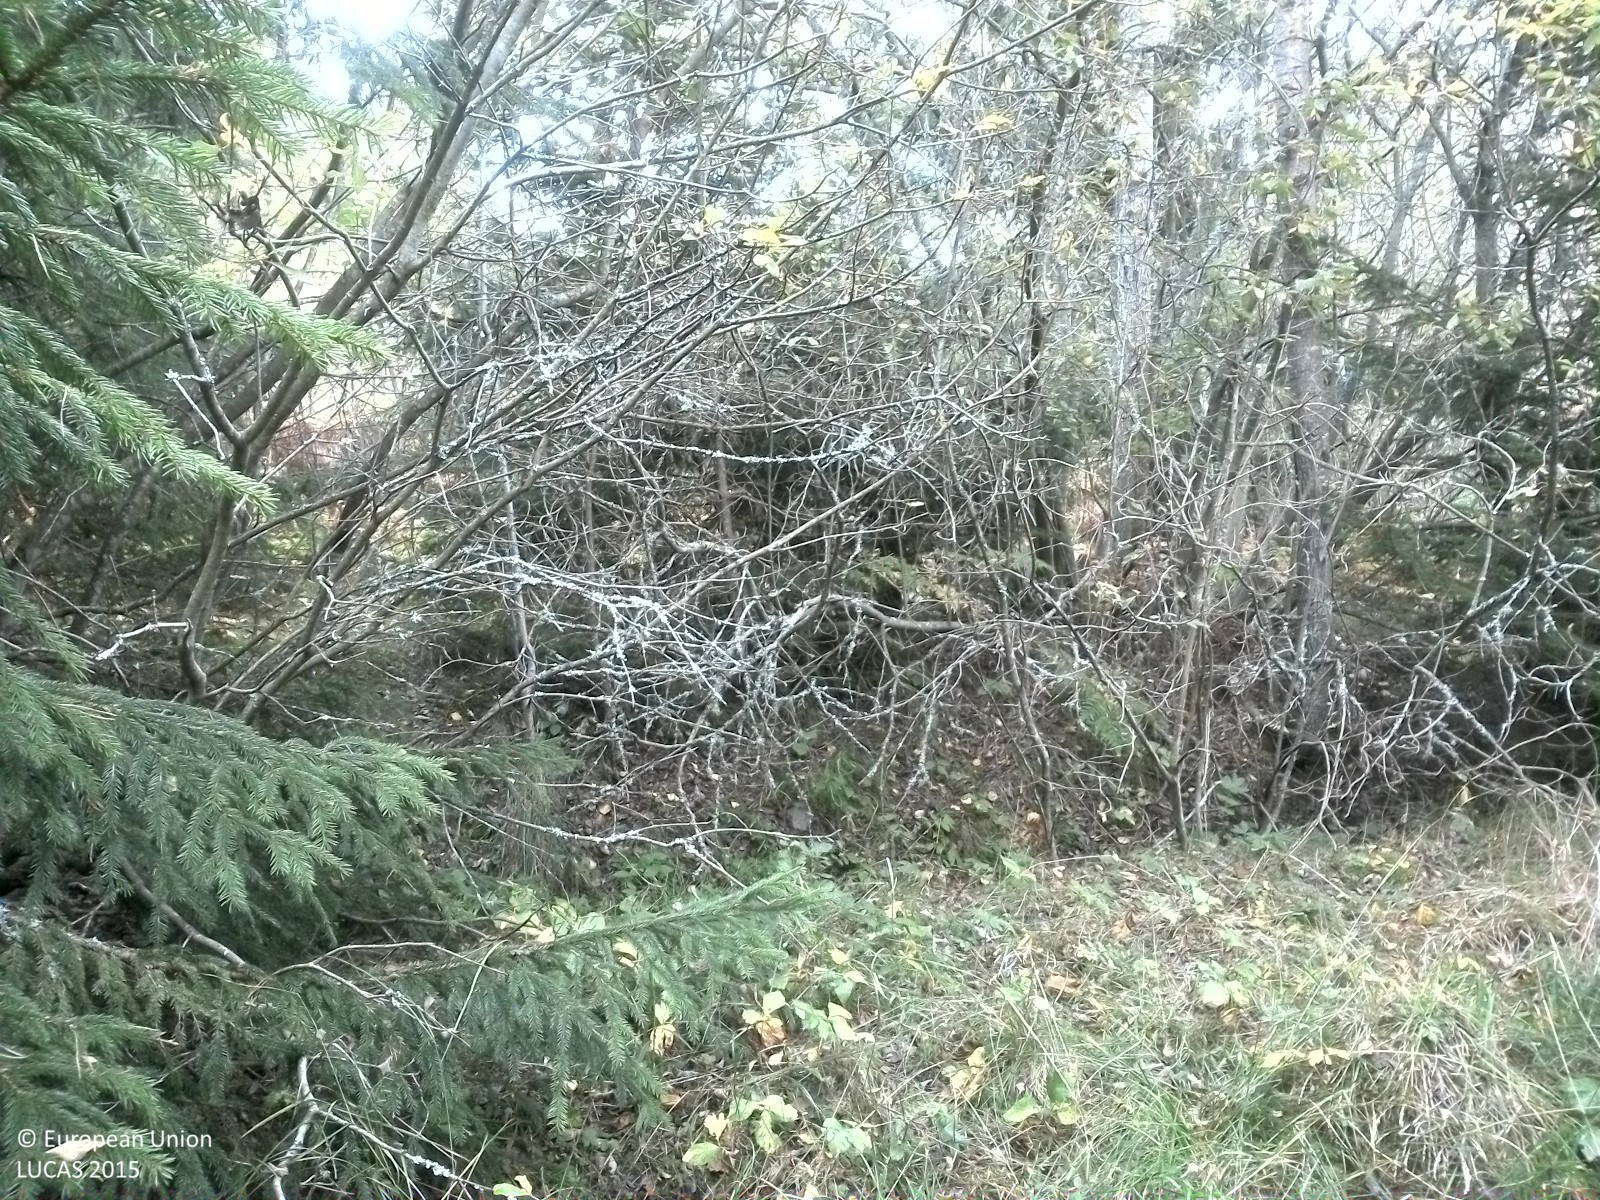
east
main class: Woodland
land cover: Pine dominated coniferous woodland
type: boreal forest
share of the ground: 50 - 75 %
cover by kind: coniferous forest trees 50 %, herbaceous plants 40 %, lichens and mosses 10 %
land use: Forestry
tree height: < 5 m
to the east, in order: Pine dominated coniferous woodland; Ditches and canals; Spruce dominated mixed woodland; Pine dominated mixed woodland; Spruce dominated mixed woodland; Ditches and canals; Grassland without tree/shrub cover; Ditches and canals; Grass margins; Paved roads, cycling and walking lanes; Grass margins; Spruce dominated mixed woodland; Spruce dominated coniferous woodland
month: September
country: SE
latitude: 58.6542
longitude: 16.9425
